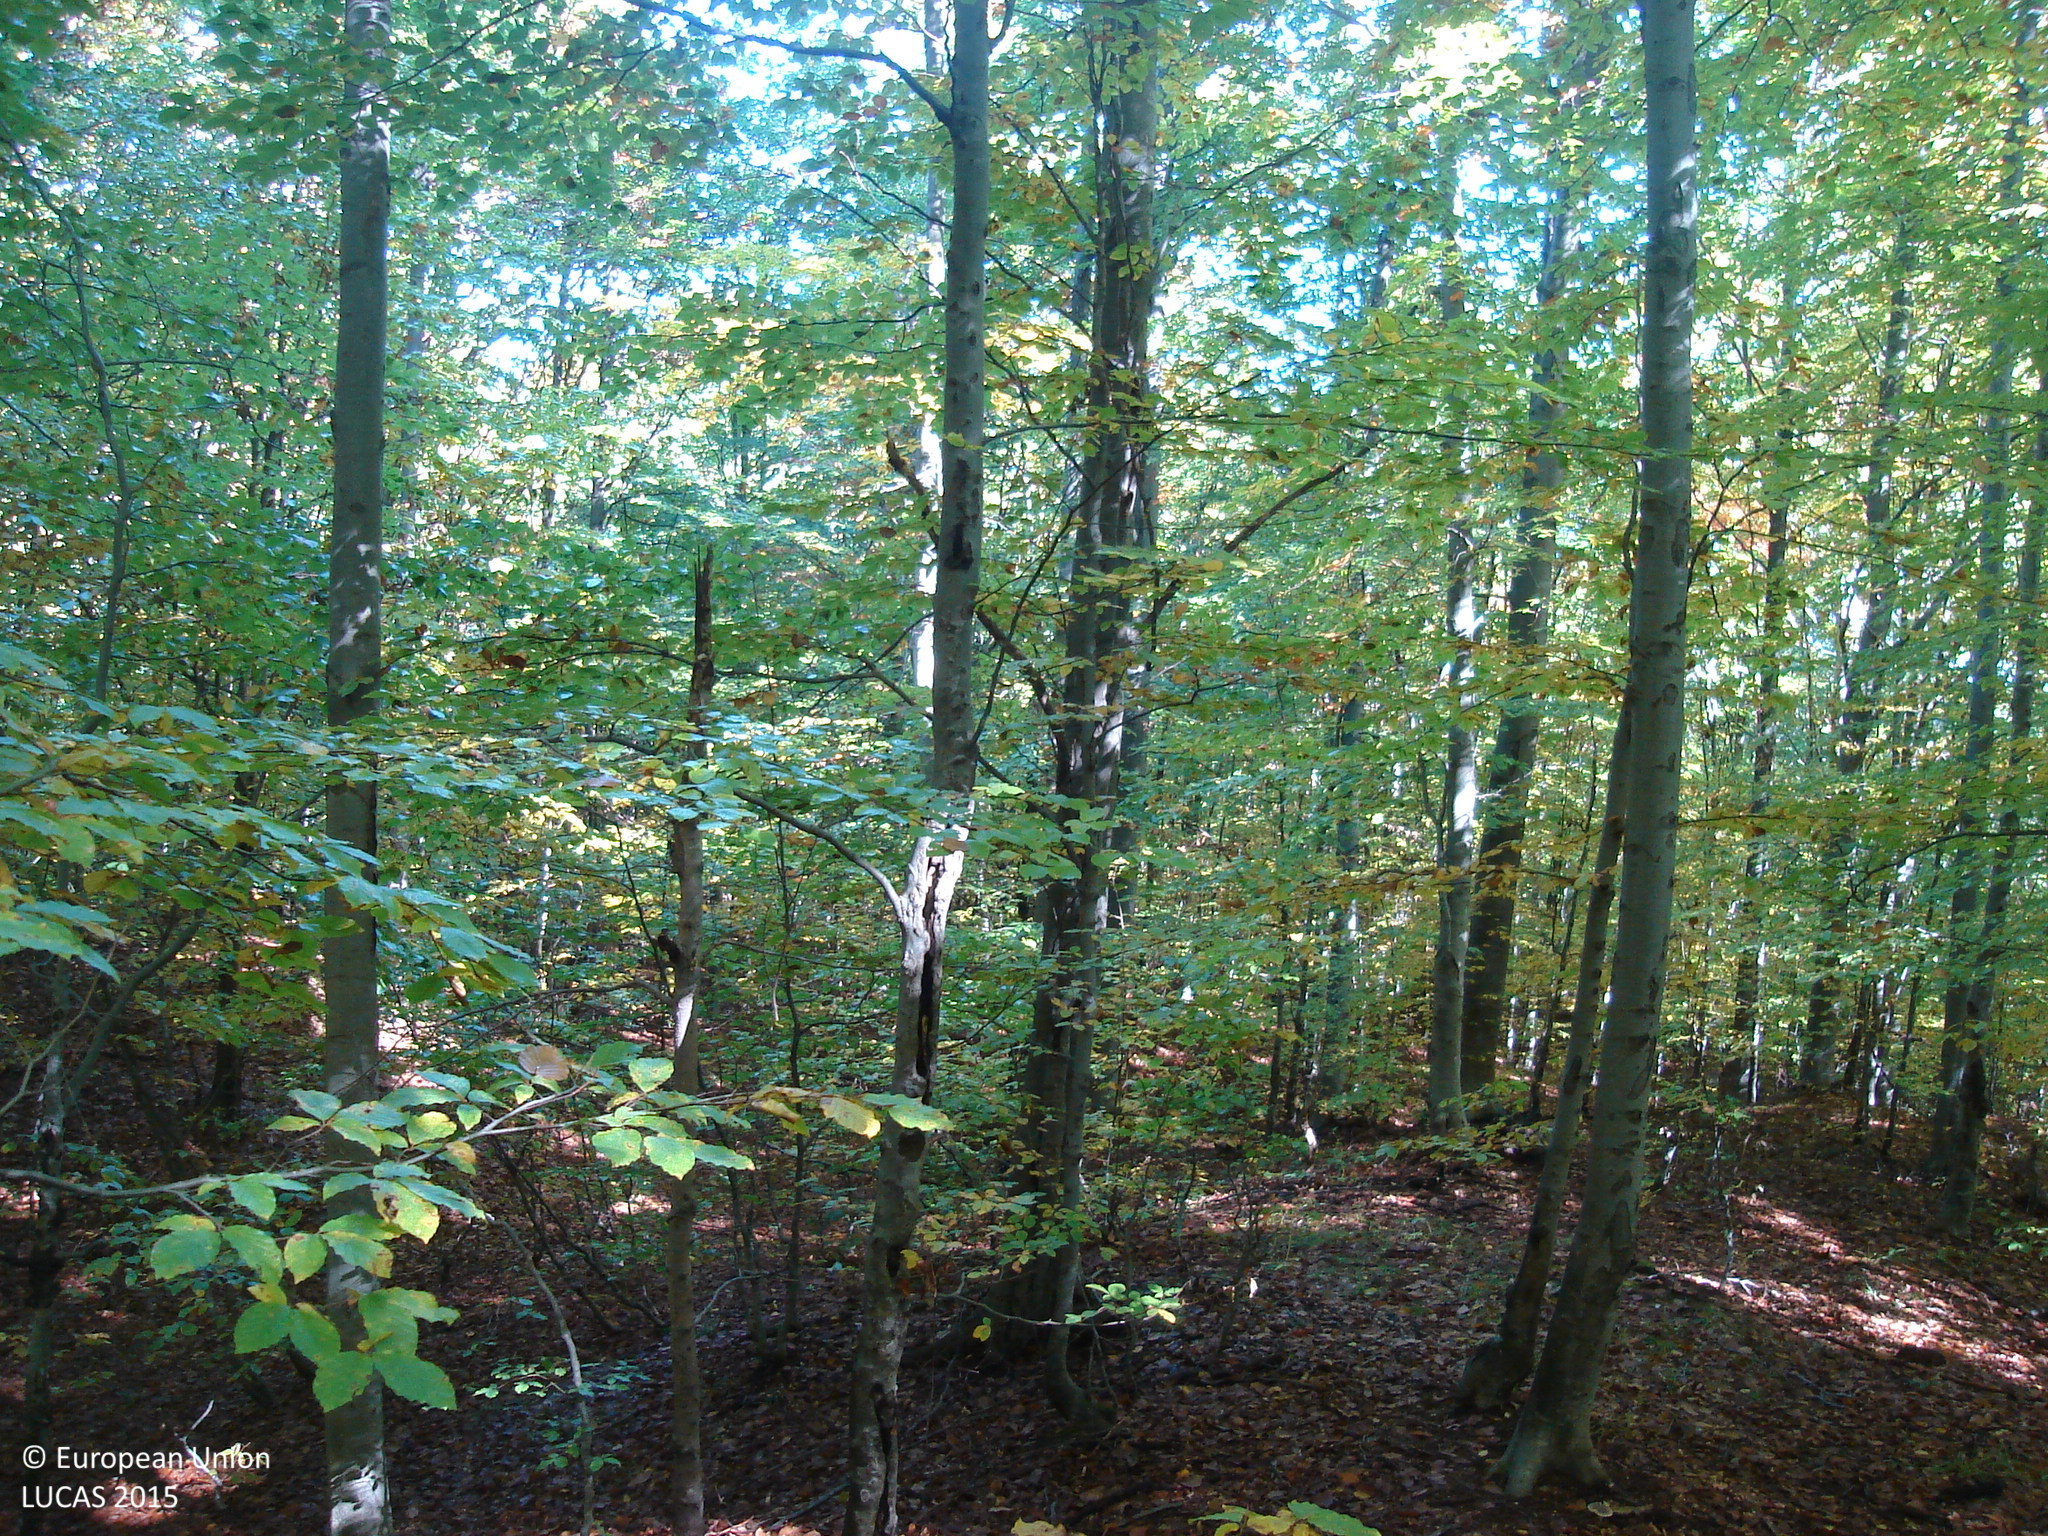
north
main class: Woodland
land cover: Broadleaved woodland
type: mountainous beech forest
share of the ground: > 75 %
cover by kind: broadleaved forest trees 80 %, unconsolidated bare surface 20 %
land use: Forestry
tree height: > 5 m
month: October
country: BG
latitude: 42.6144
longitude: 24.2254
